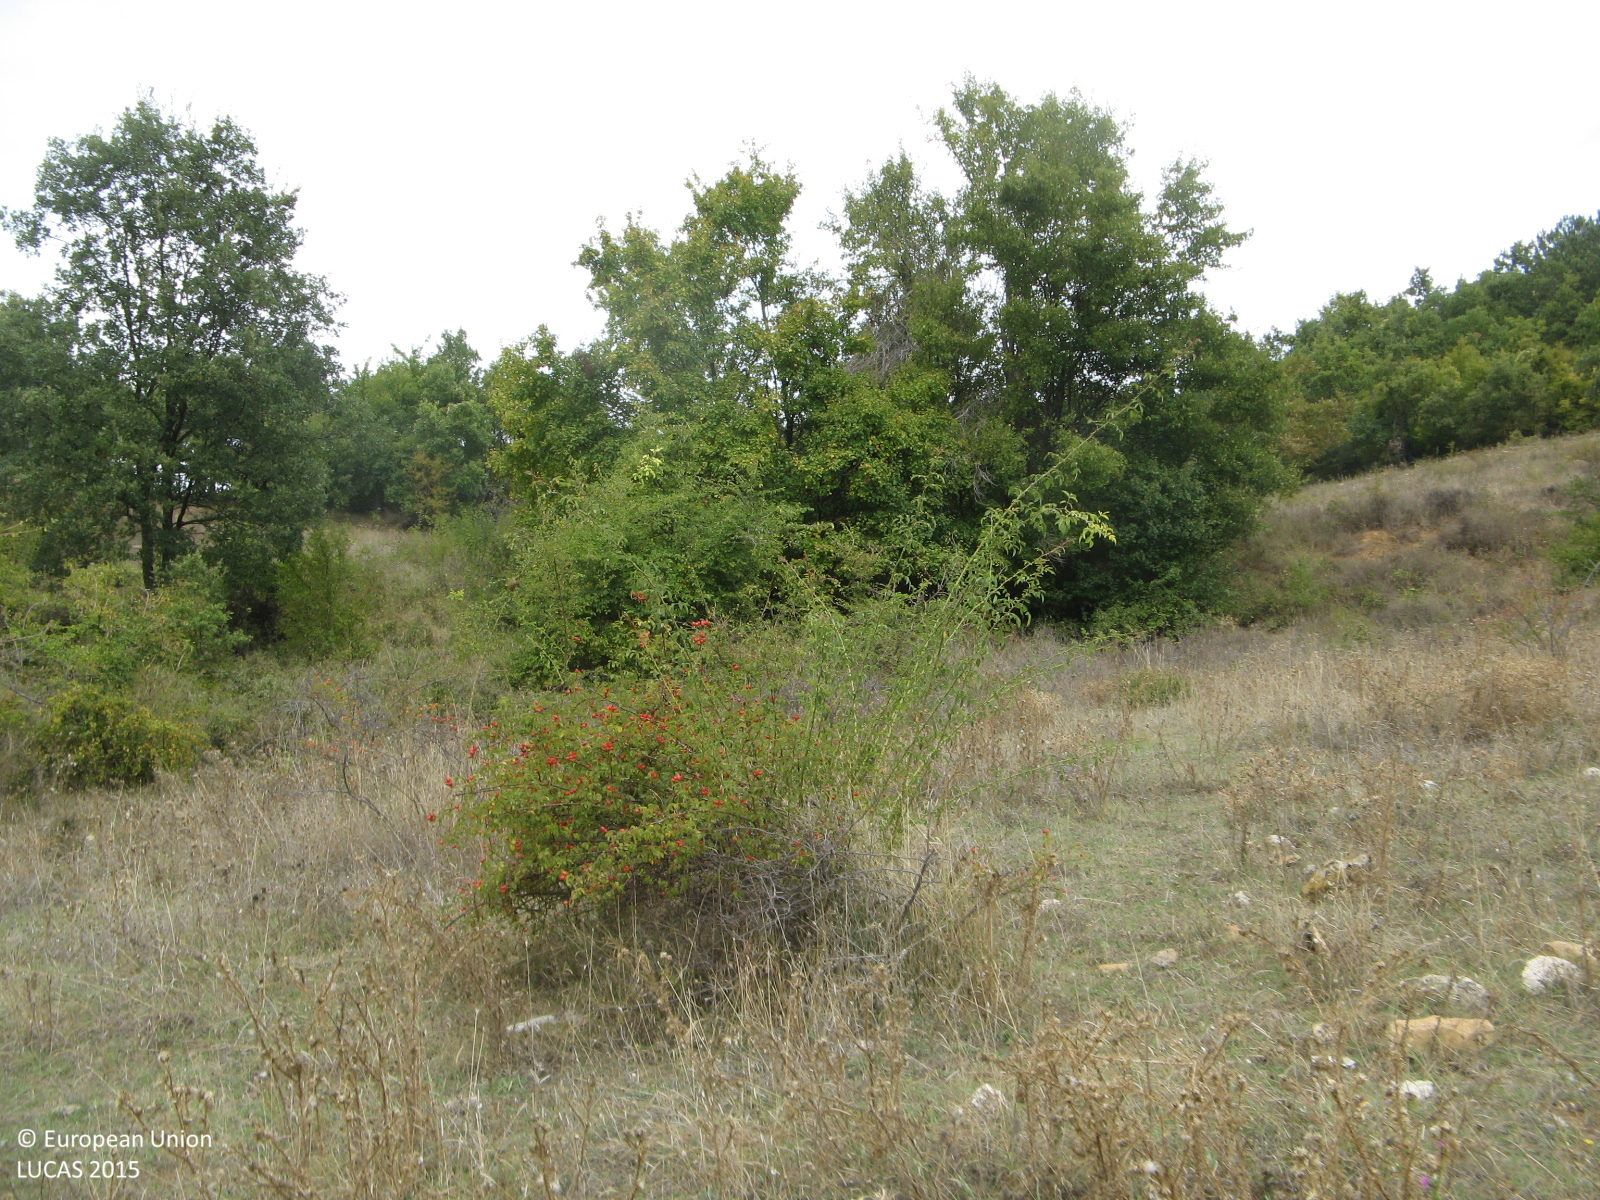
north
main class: Grassland
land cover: Grassland with sparse tree/shrub cover
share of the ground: > 75 %
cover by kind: herbaceous plants 85 %, shrubs 10 %, broadleaved forest trees 5 %
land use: Agriculture (excluding fallow land and kitchen gardens)
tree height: < 5 m
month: October
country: BG
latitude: 41.6919
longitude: 25.3768
